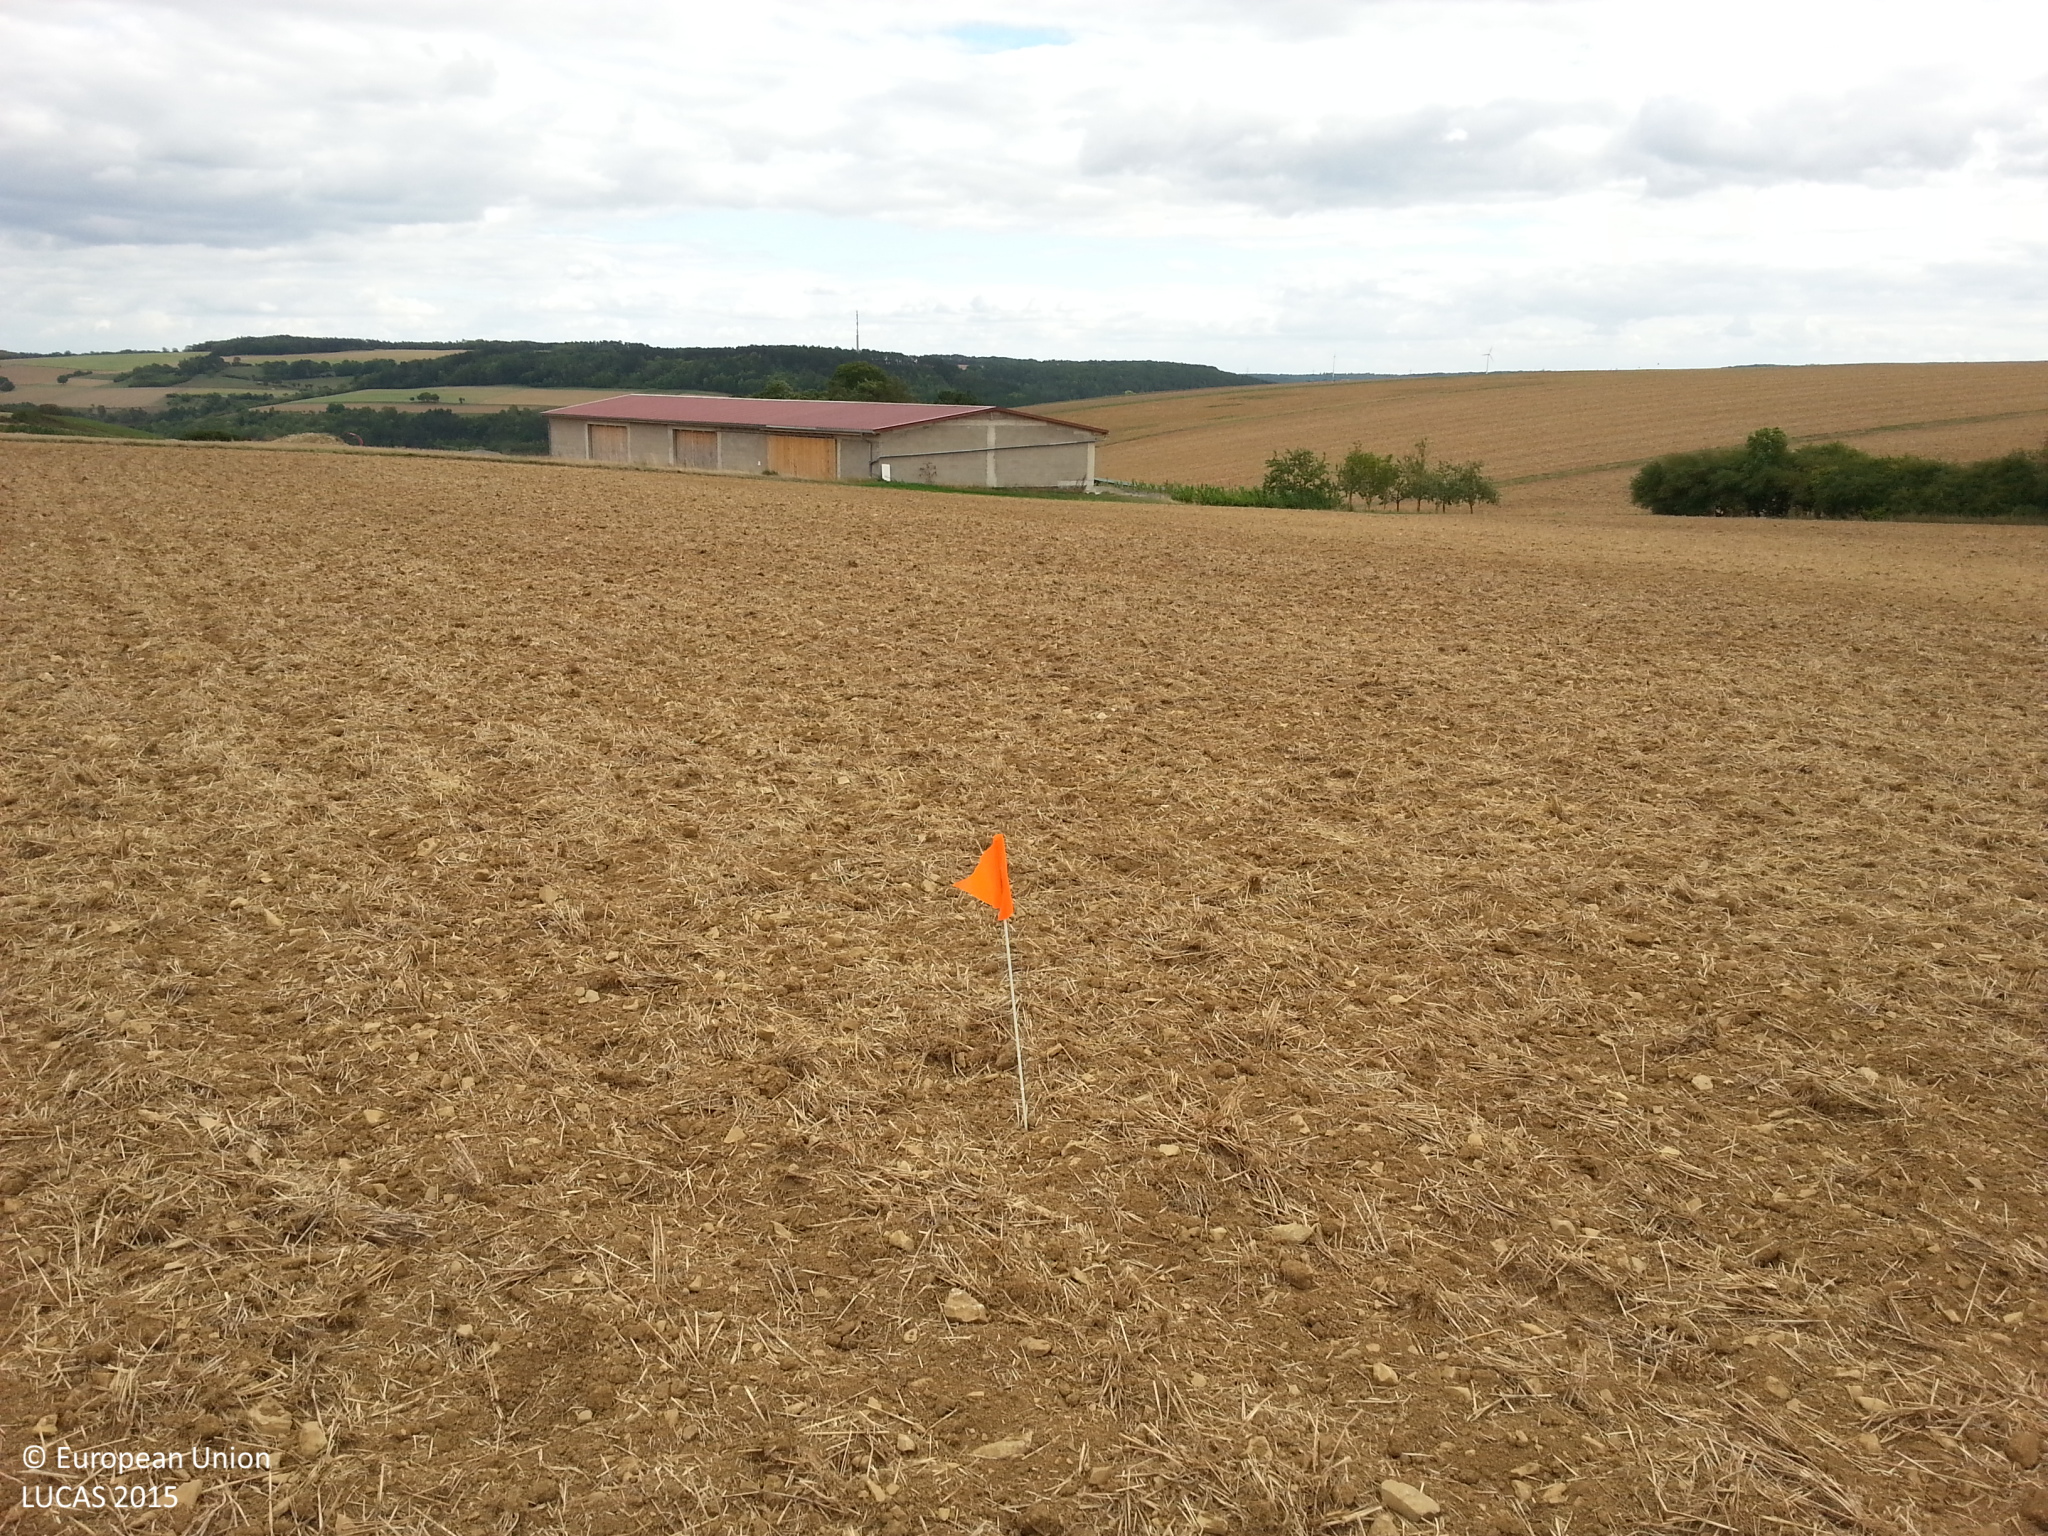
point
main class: Cropland
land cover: Common wheat
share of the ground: < 10 %
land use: Agriculture (excluding fallow land and kitchen gardens)
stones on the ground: 10 - 25 %
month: September
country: DE
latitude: 49.6259
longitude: 9.5710
